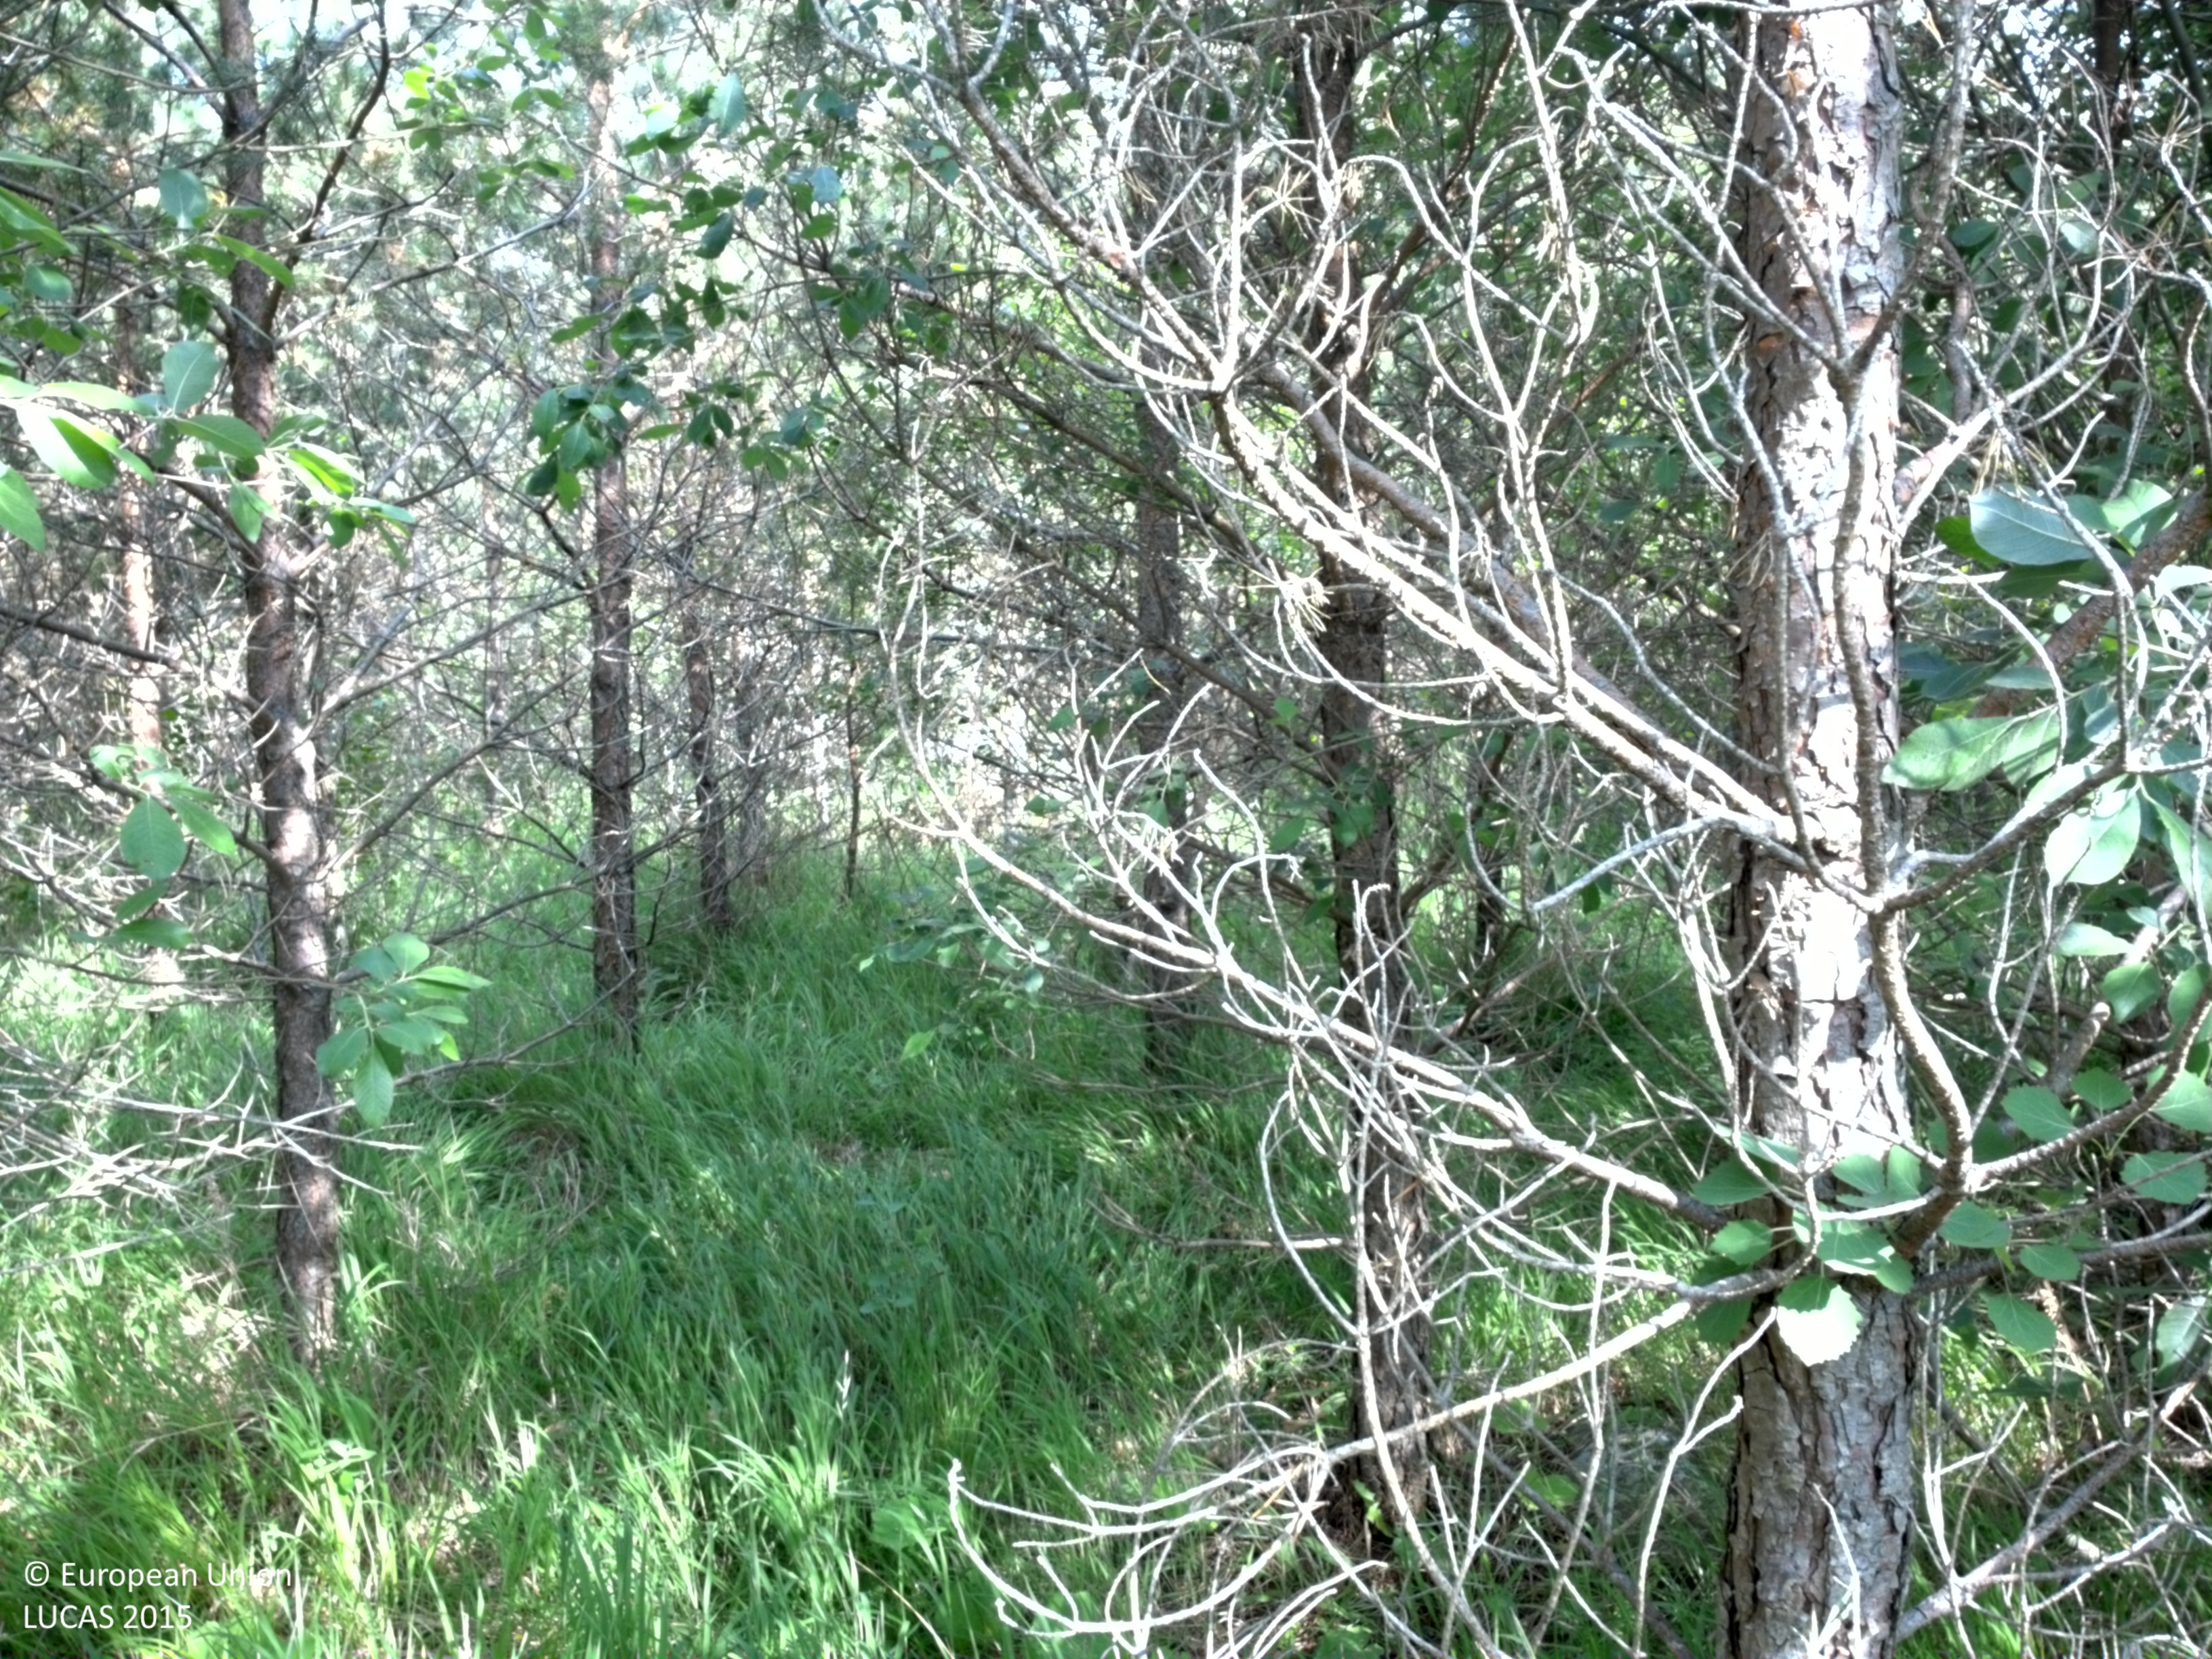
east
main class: Woodland
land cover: Pine dominated mixed woodland
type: hemiboreal forest and nemoral coniferous forest and mixed broadleaved-coniferous forest
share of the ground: > 75 %
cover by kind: coniferous forest trees 55 %, broadleaved forest trees 25 %, herbaceous plants 20 %
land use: Forestry
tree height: < 5 m
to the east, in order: Pine dominated mixed woodland; Broadleaved woodland; Other mixed woodland; Grassland with sparse tree/shrub cover; Other mixed woodland
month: July
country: SE
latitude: 57.4288
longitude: 18.7209
